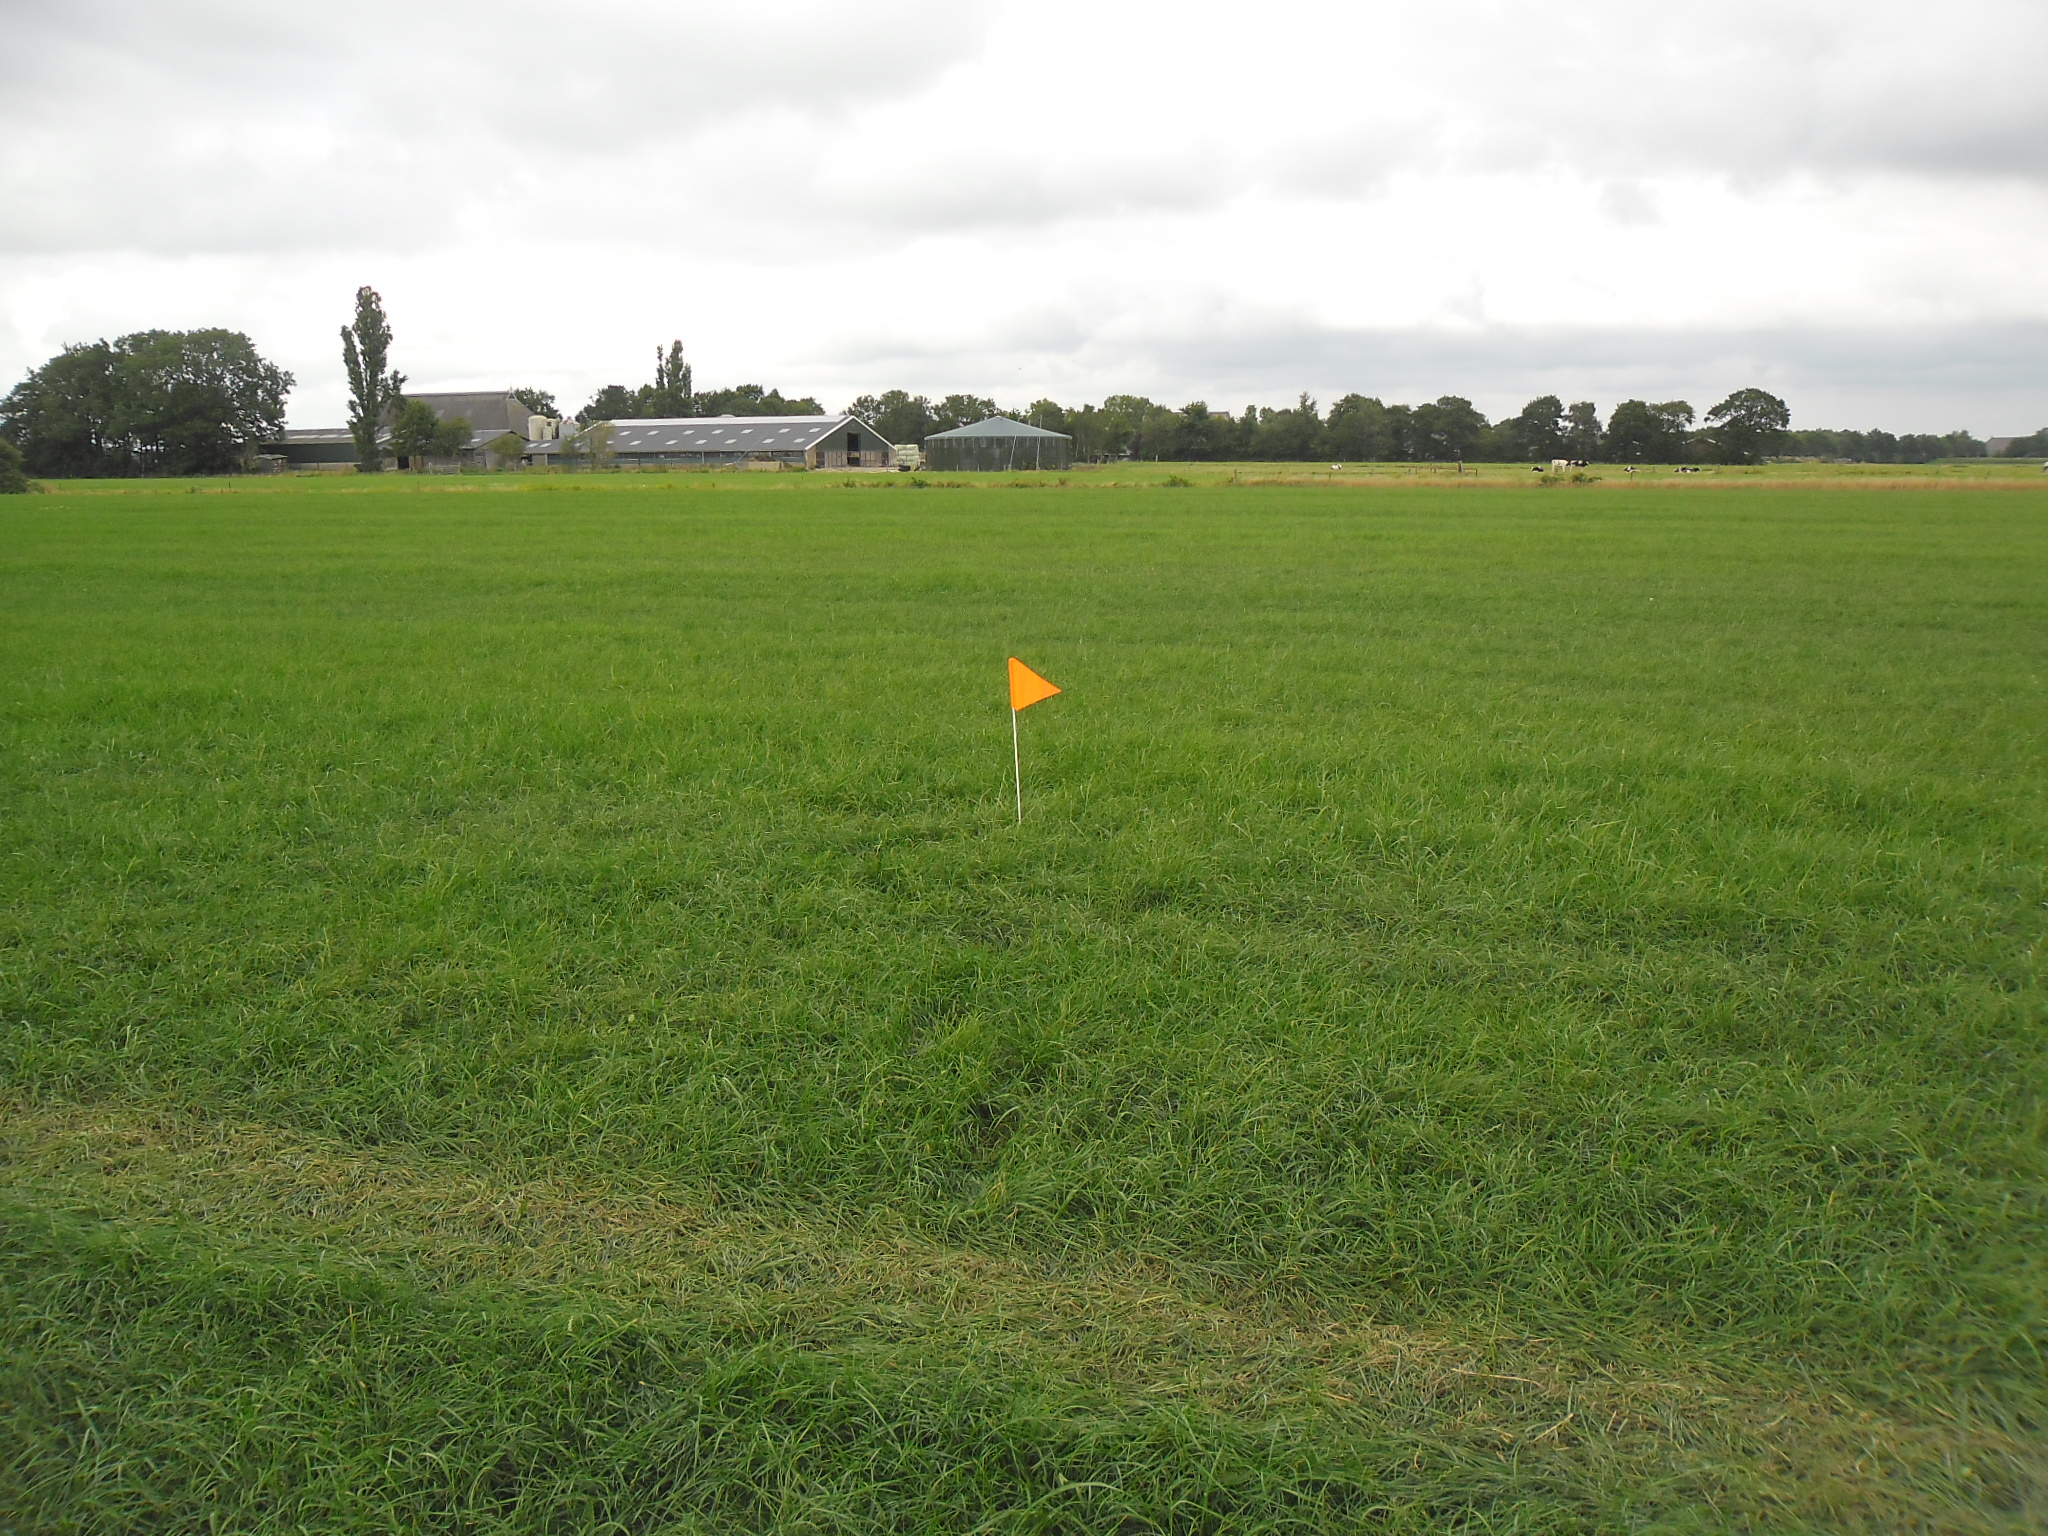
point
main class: Grassland
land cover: Grassland without tree/shrub cover
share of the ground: > 75 %
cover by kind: herbaceous plants 100 %
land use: Agriculture (excluding fallow land and kitchen gardens)
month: August
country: NL
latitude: 52.8536
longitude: 5.5882
